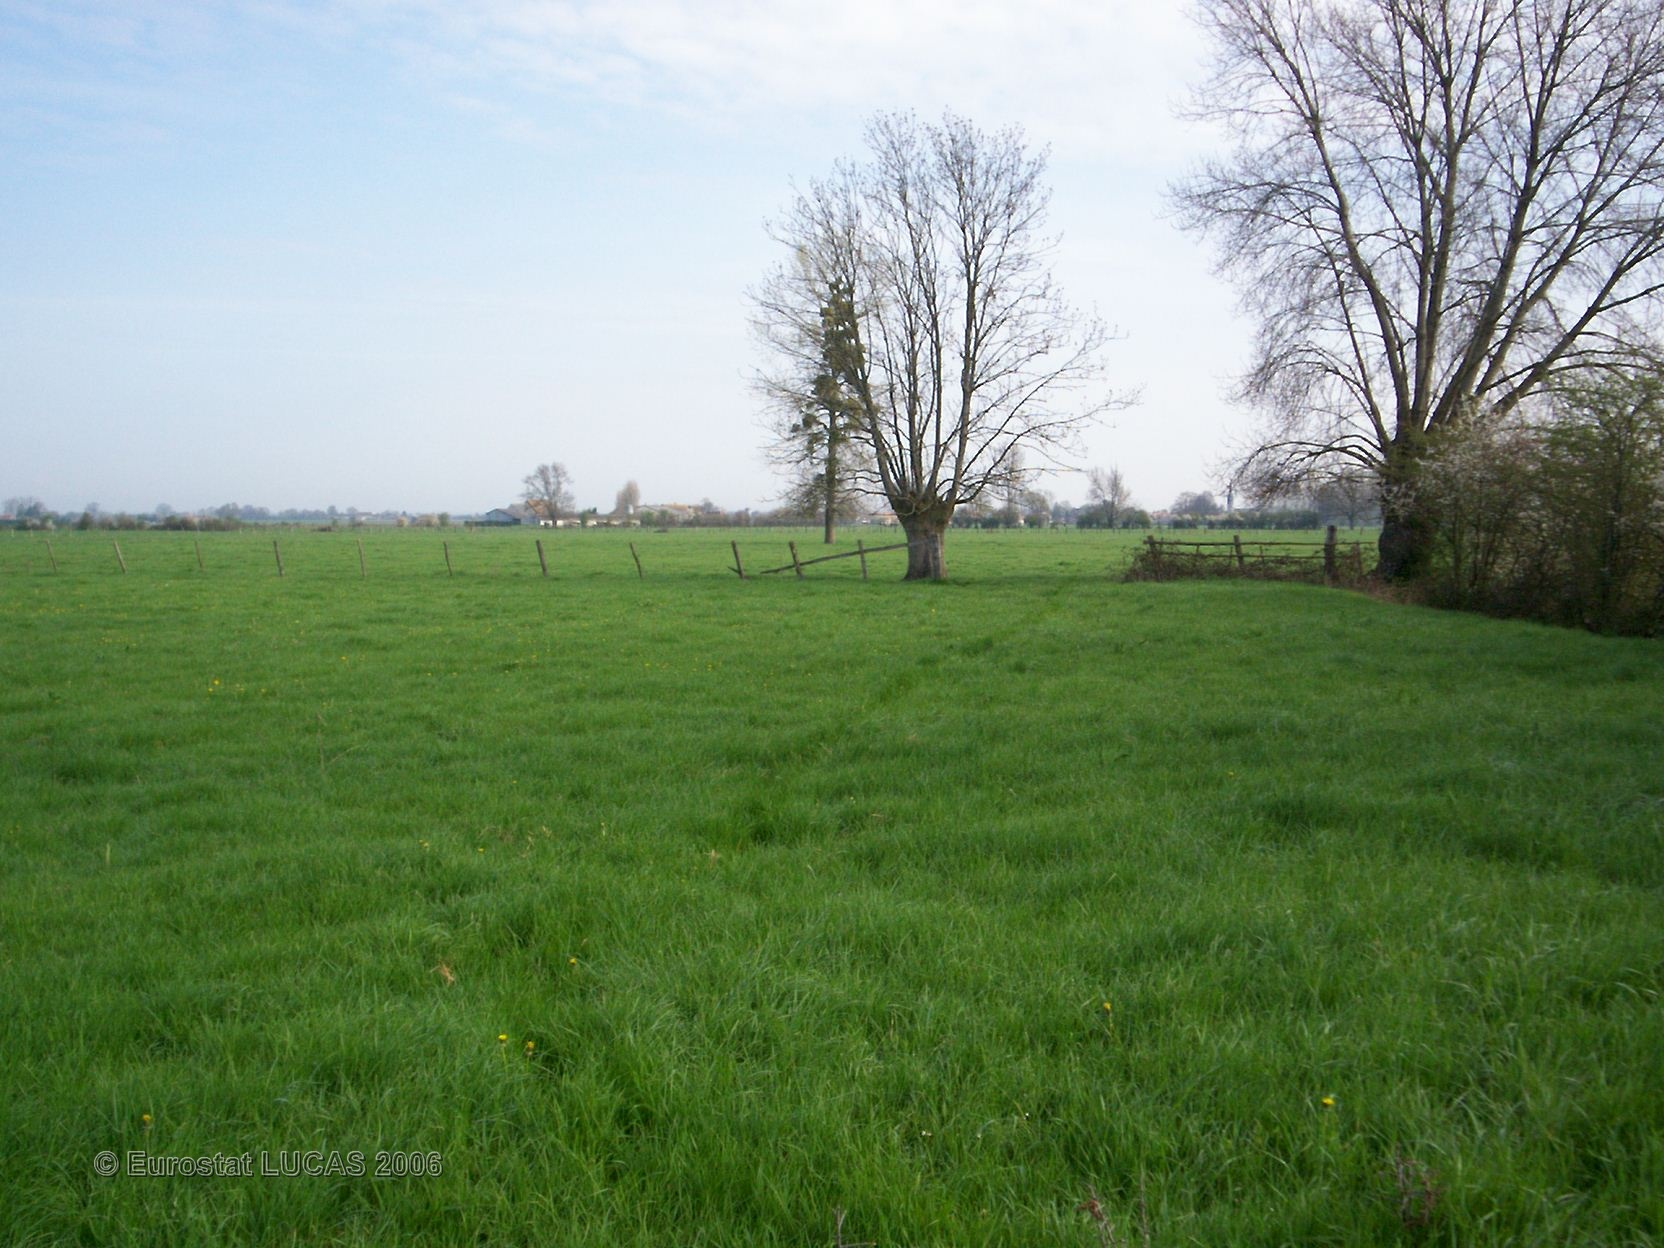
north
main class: Grassland
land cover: Grassland with sparse tree/shrub cover
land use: Agriculture (excluding fallow land and kitchen gardens)
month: April
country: FR
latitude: 48.1889
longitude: 0.2482
